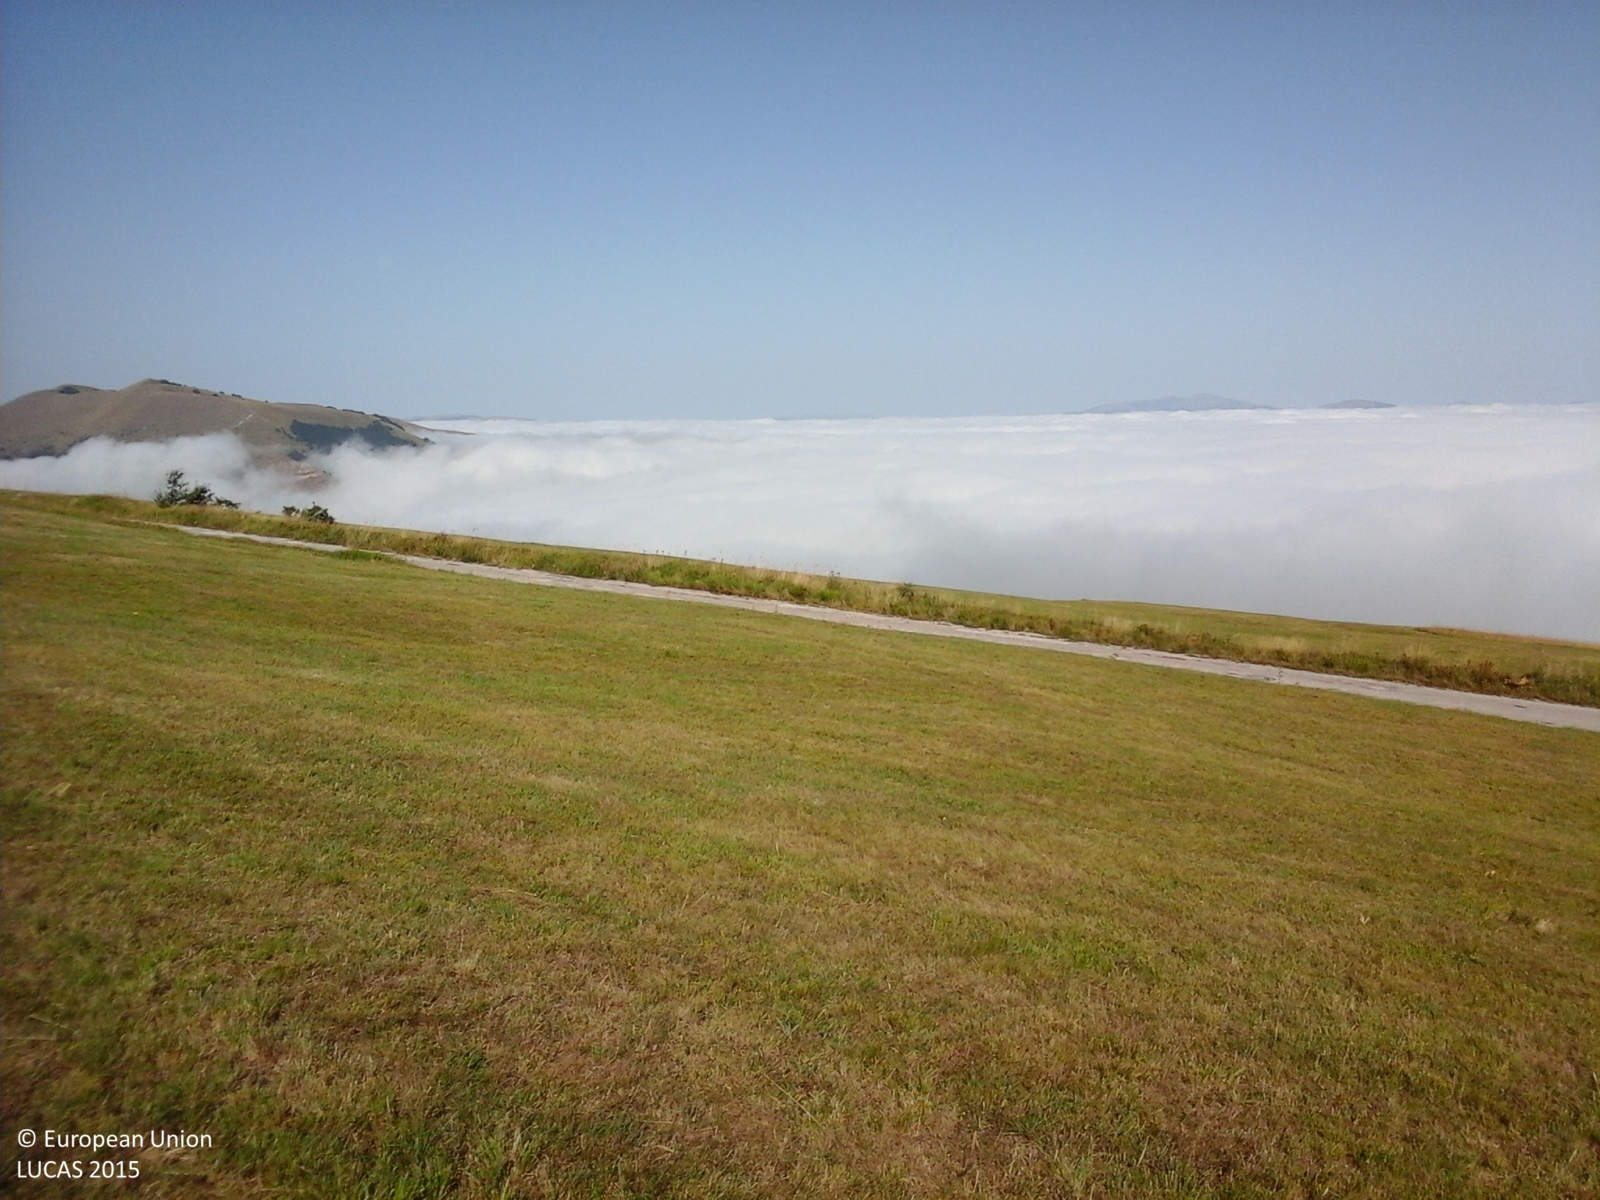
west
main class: Grassland
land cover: Grassland without tree/shrub cover
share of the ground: > 75 %
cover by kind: herbaceous plants 100 %
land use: Agriculture (excluding fallow land and kitchen gardens)
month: August
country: IT
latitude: 43.0185
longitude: 13.2181
